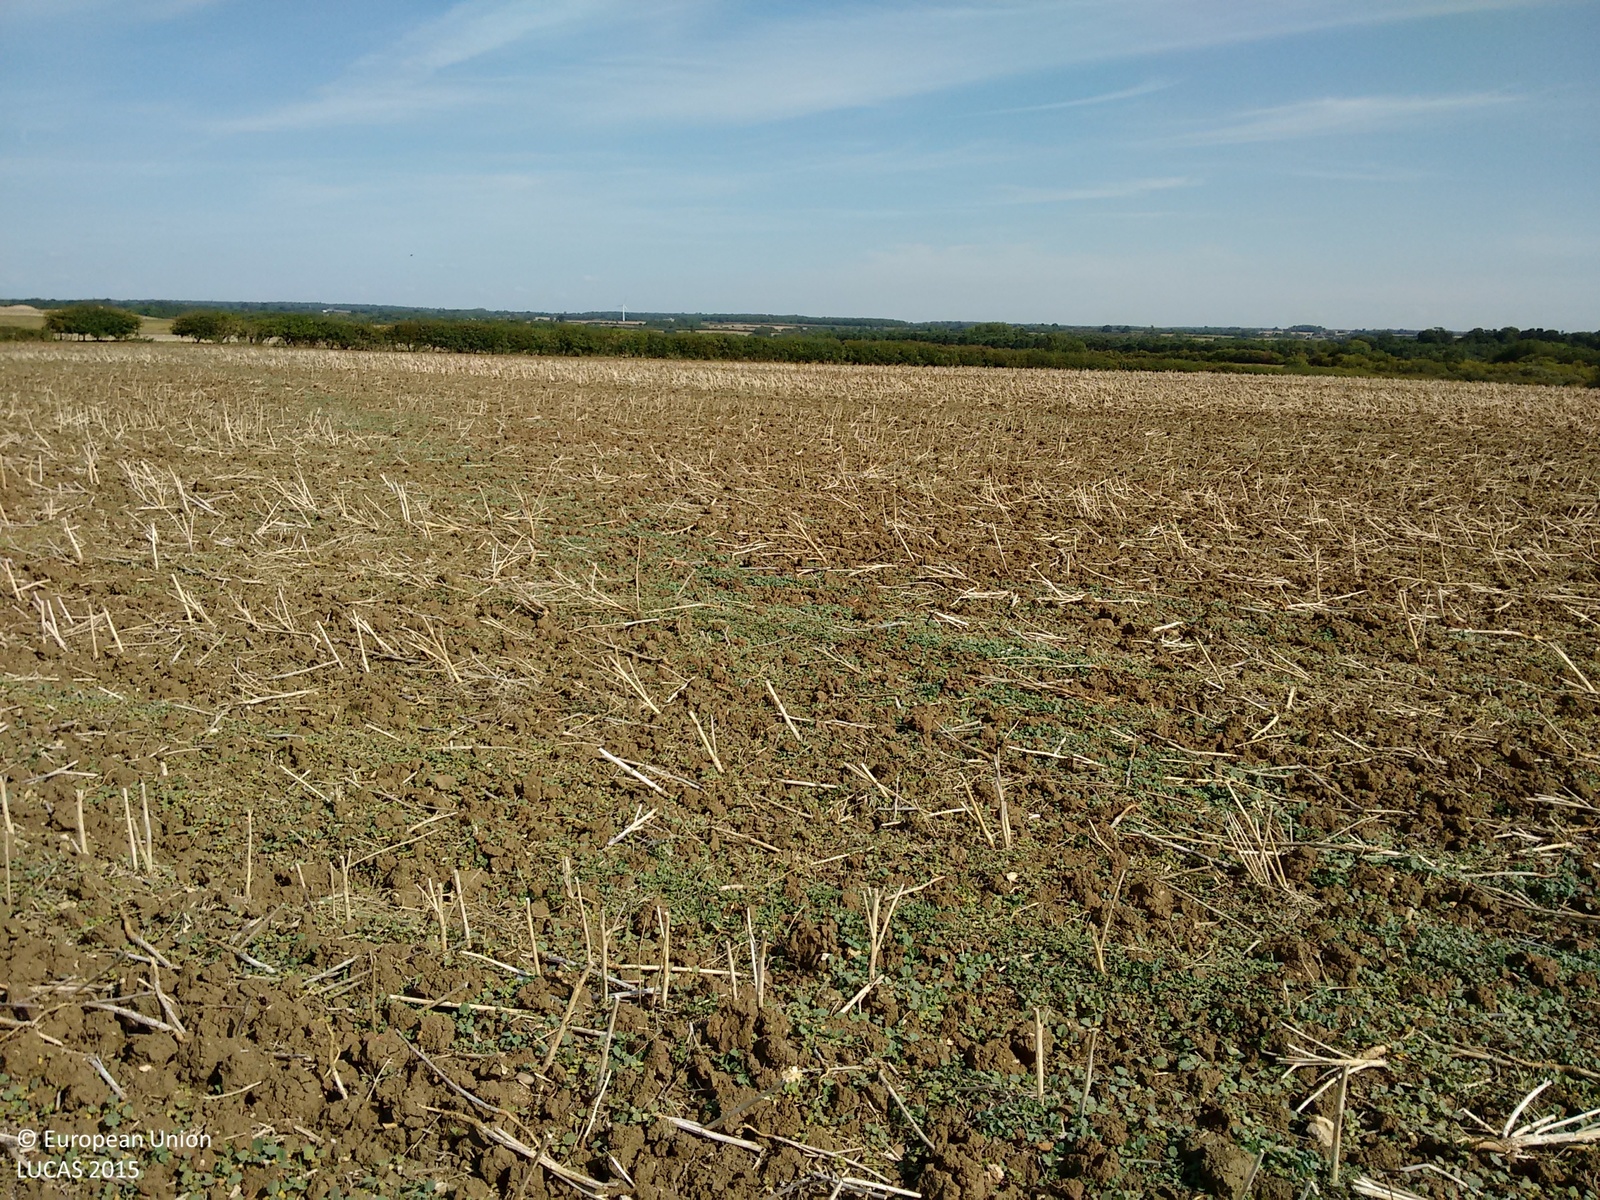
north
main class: Cropland
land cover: Rape and turnip rape
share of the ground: < 10 %
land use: Agriculture (excluding fallow land and kitchen gardens)
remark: Harvested field
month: August
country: GB
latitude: 52.3704
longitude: -0.6294
